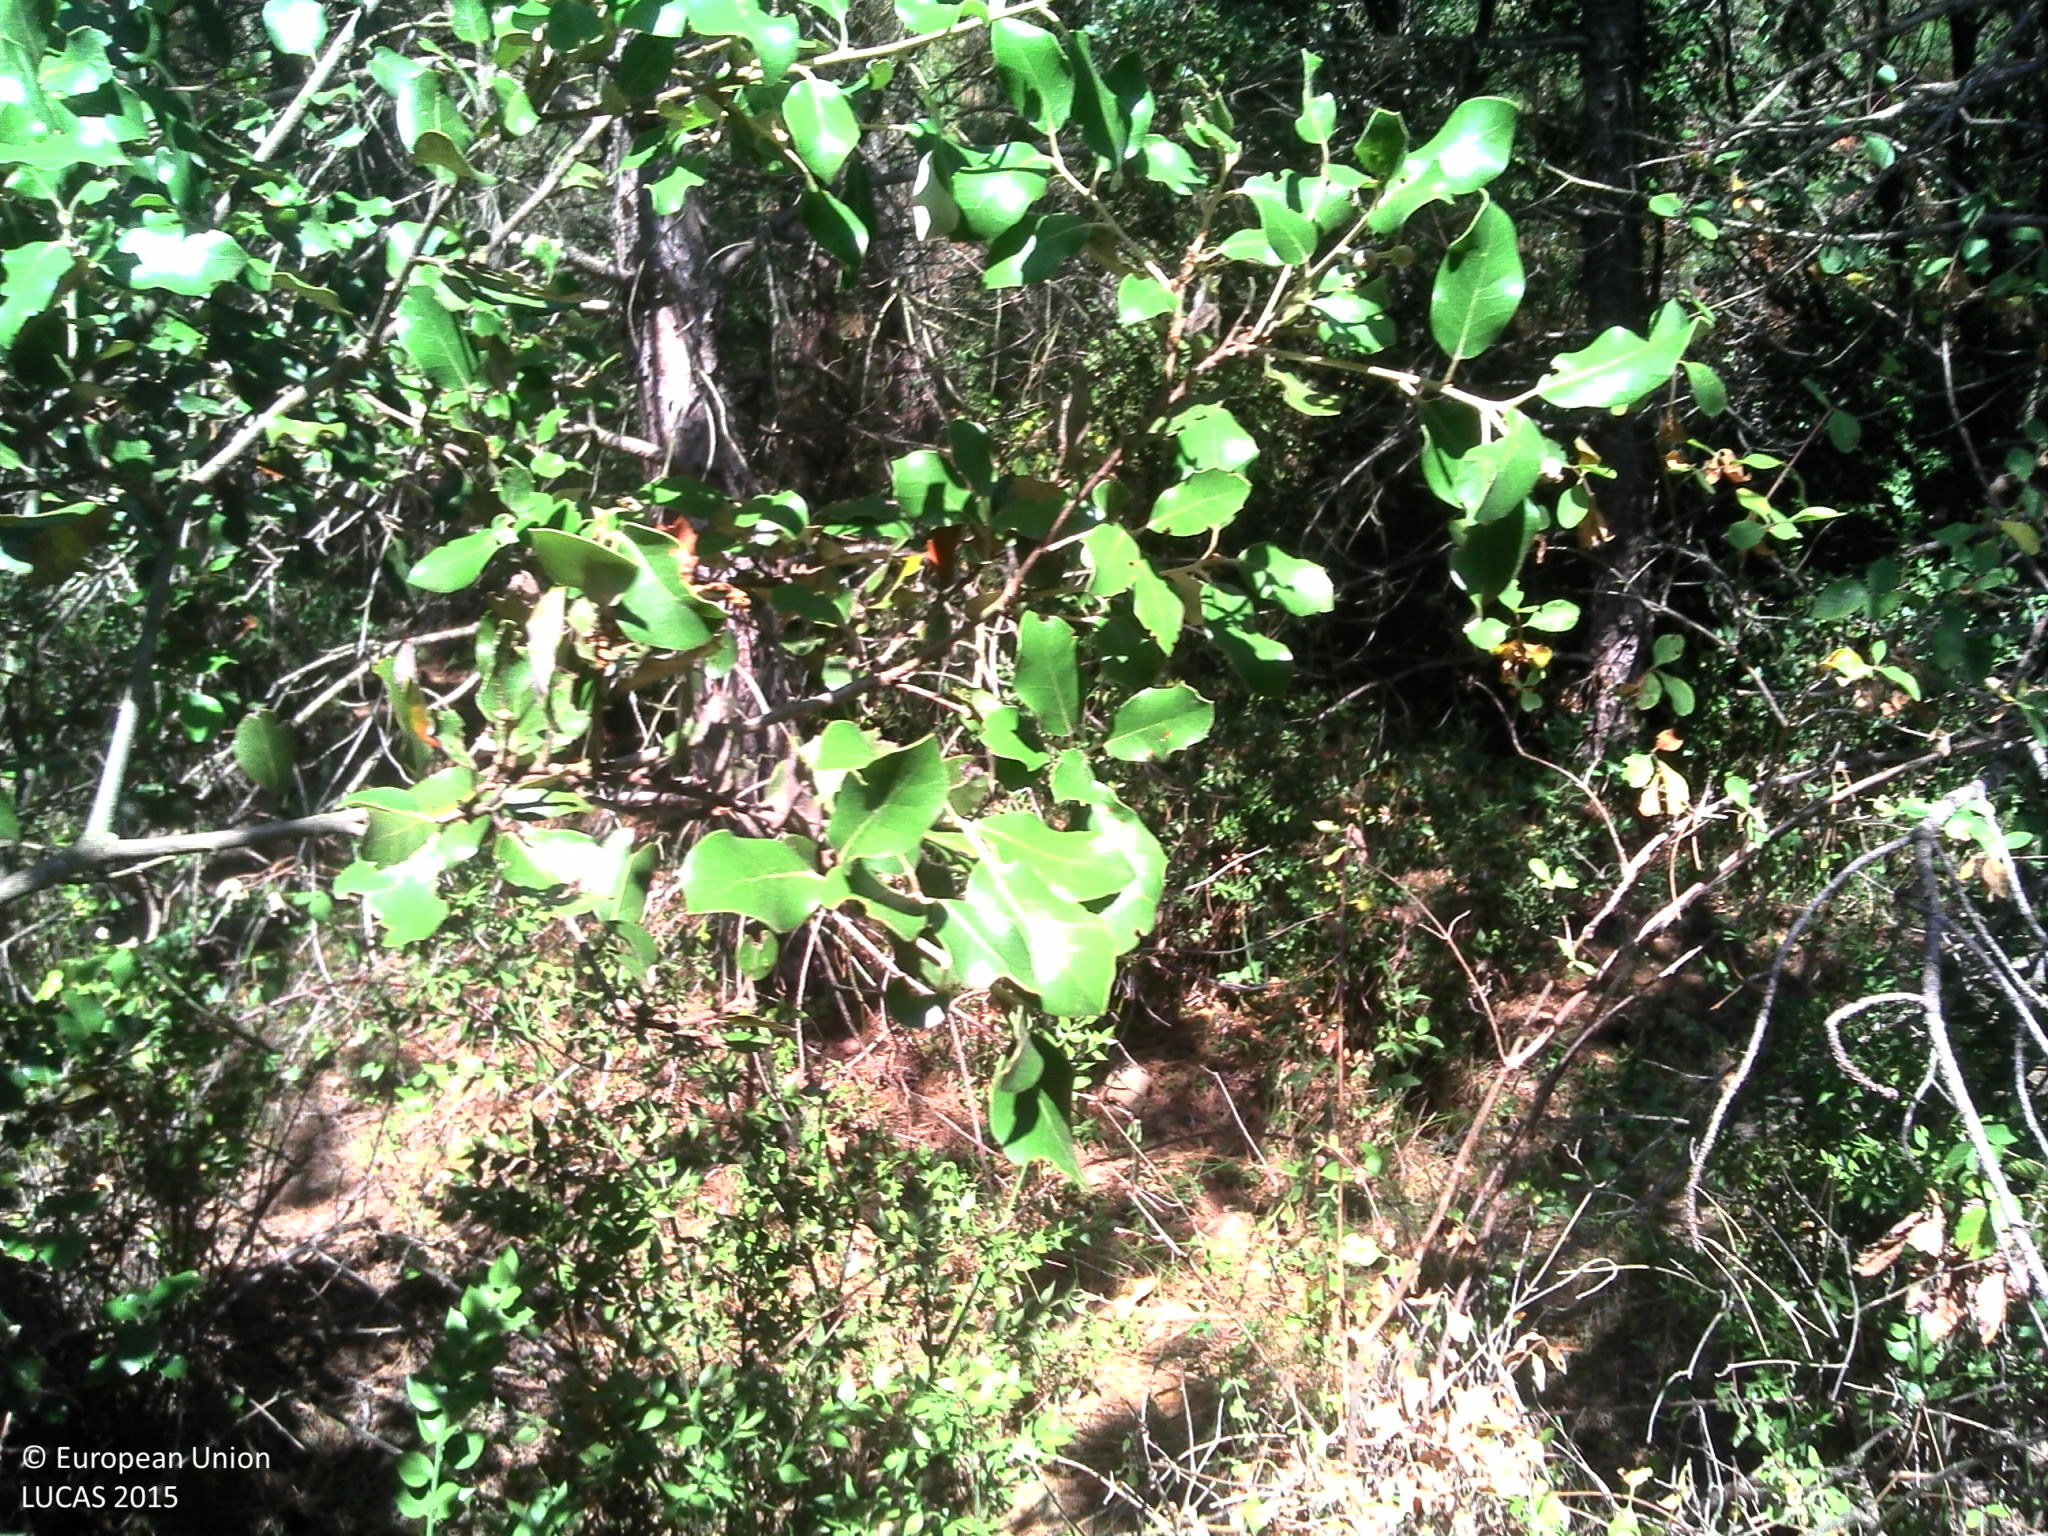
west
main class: Woodland
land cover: Pine dominated mixed woodland
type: coniferous forest of the mediterranean region
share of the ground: > 75 %
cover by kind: coniferous forest trees 50 %, broadleaved forest trees 50 %
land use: Forestry
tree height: > 5 m
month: July
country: FR
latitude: 44.3120
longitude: 4.8298
